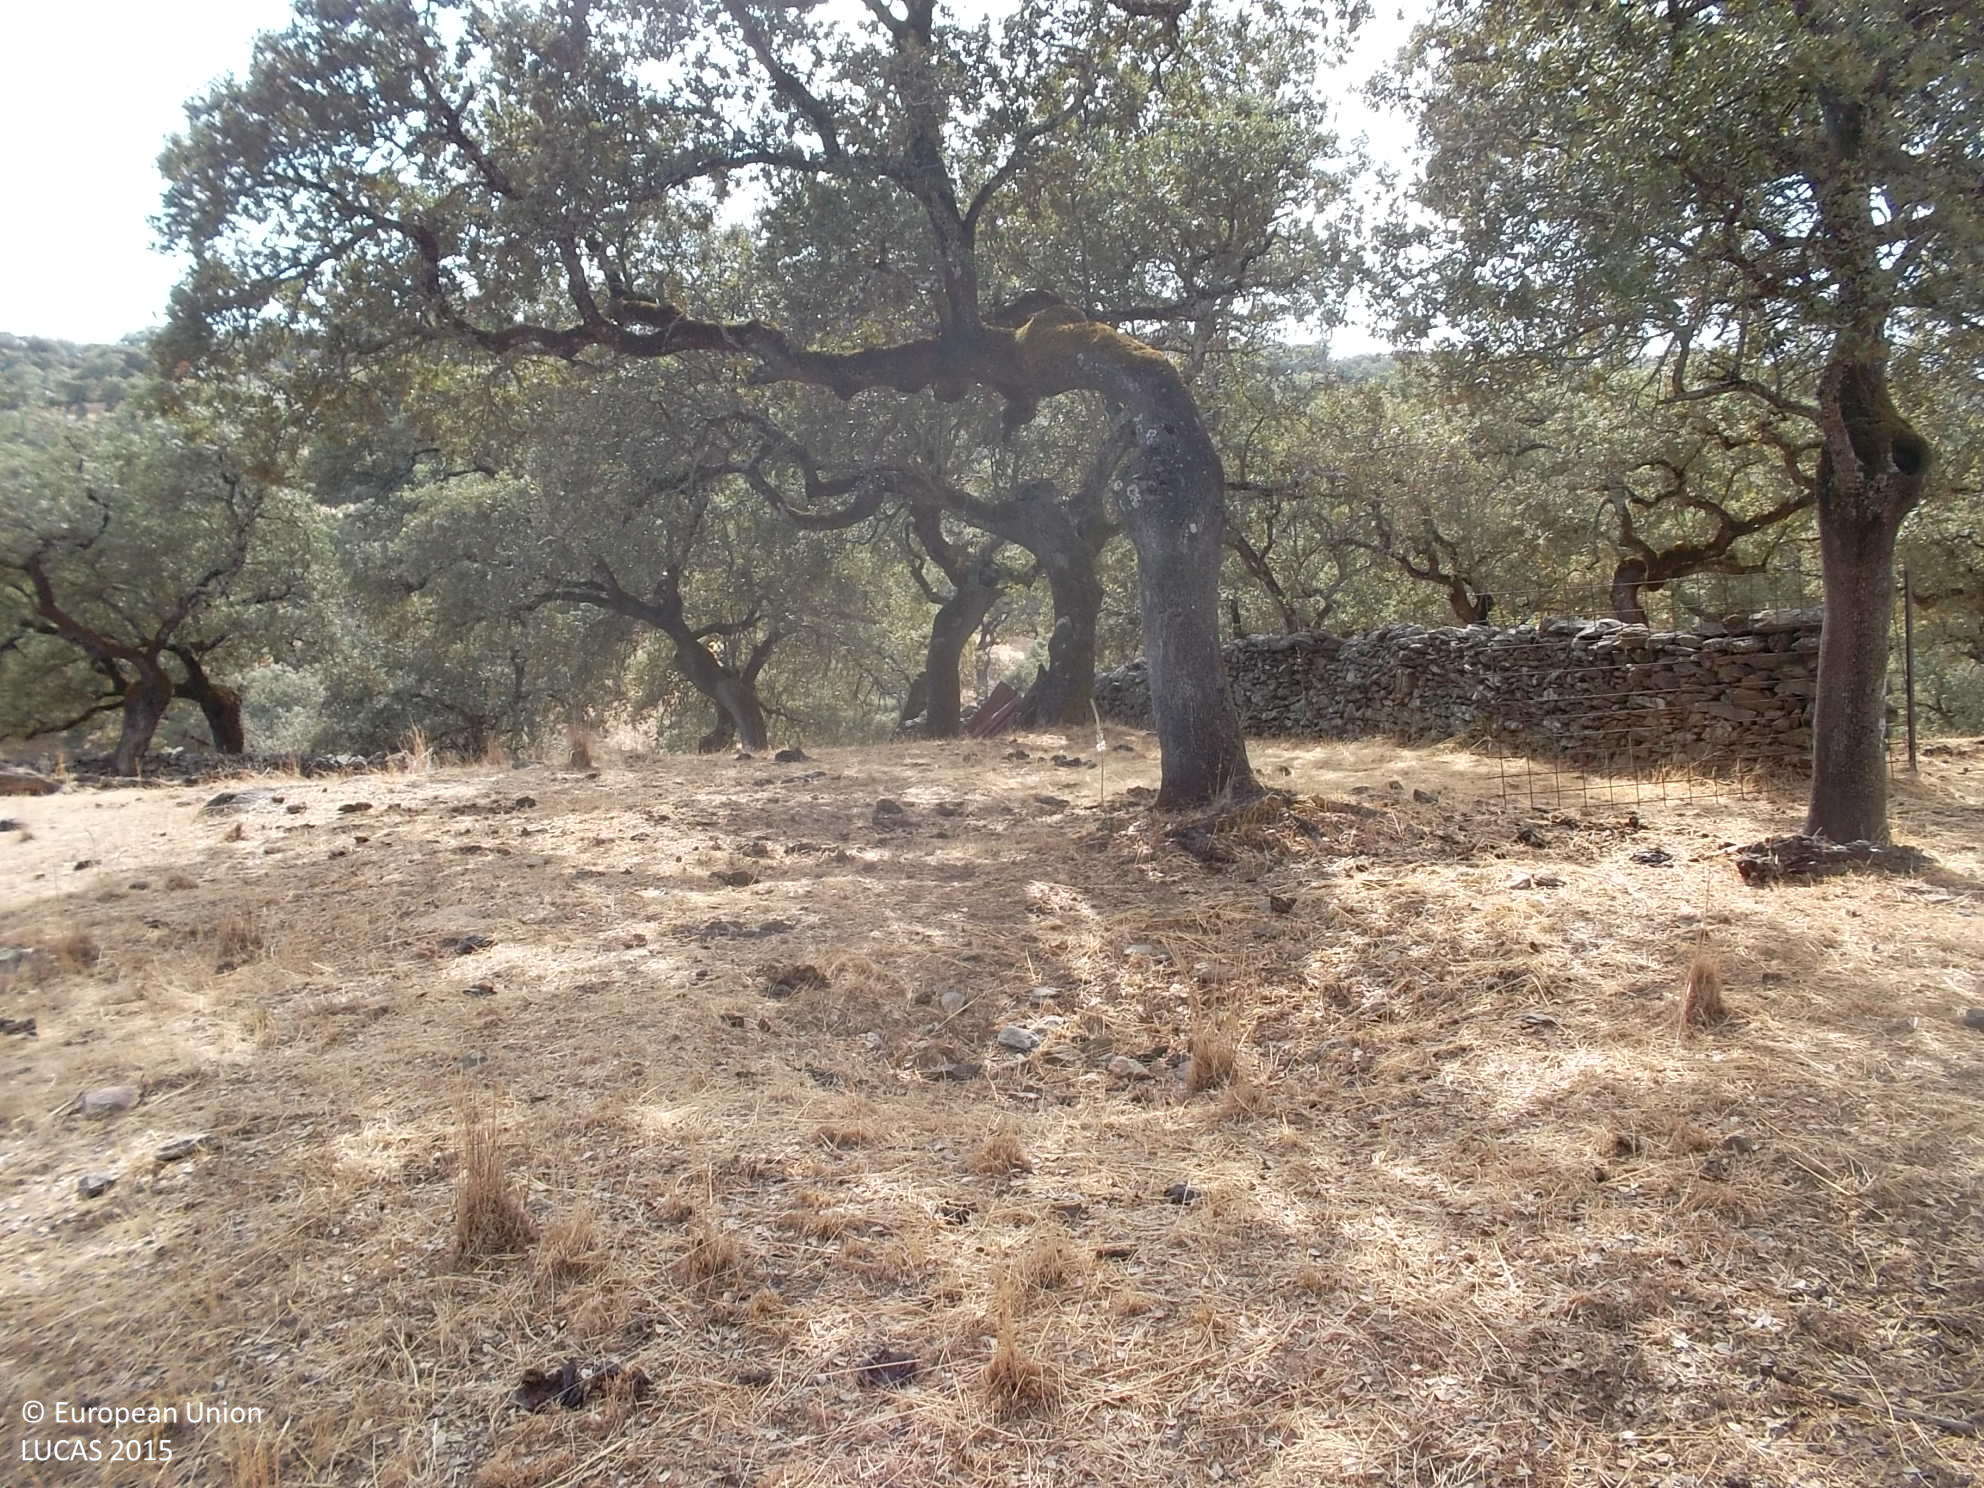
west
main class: Woodland
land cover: Broadleaved woodland
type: broadleaved evergreen forest
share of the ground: 50 - 75 %
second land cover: Grassland without tree/shrub cover
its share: > 75 %
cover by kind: broadleaved forest trees 50 %, herbaceous plants 50 %
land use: Forestry
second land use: Agriculture (excluding fallow land and kitchen gardens)
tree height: > 5 m
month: September
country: ES
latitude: 38.0503
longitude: -6.4890
